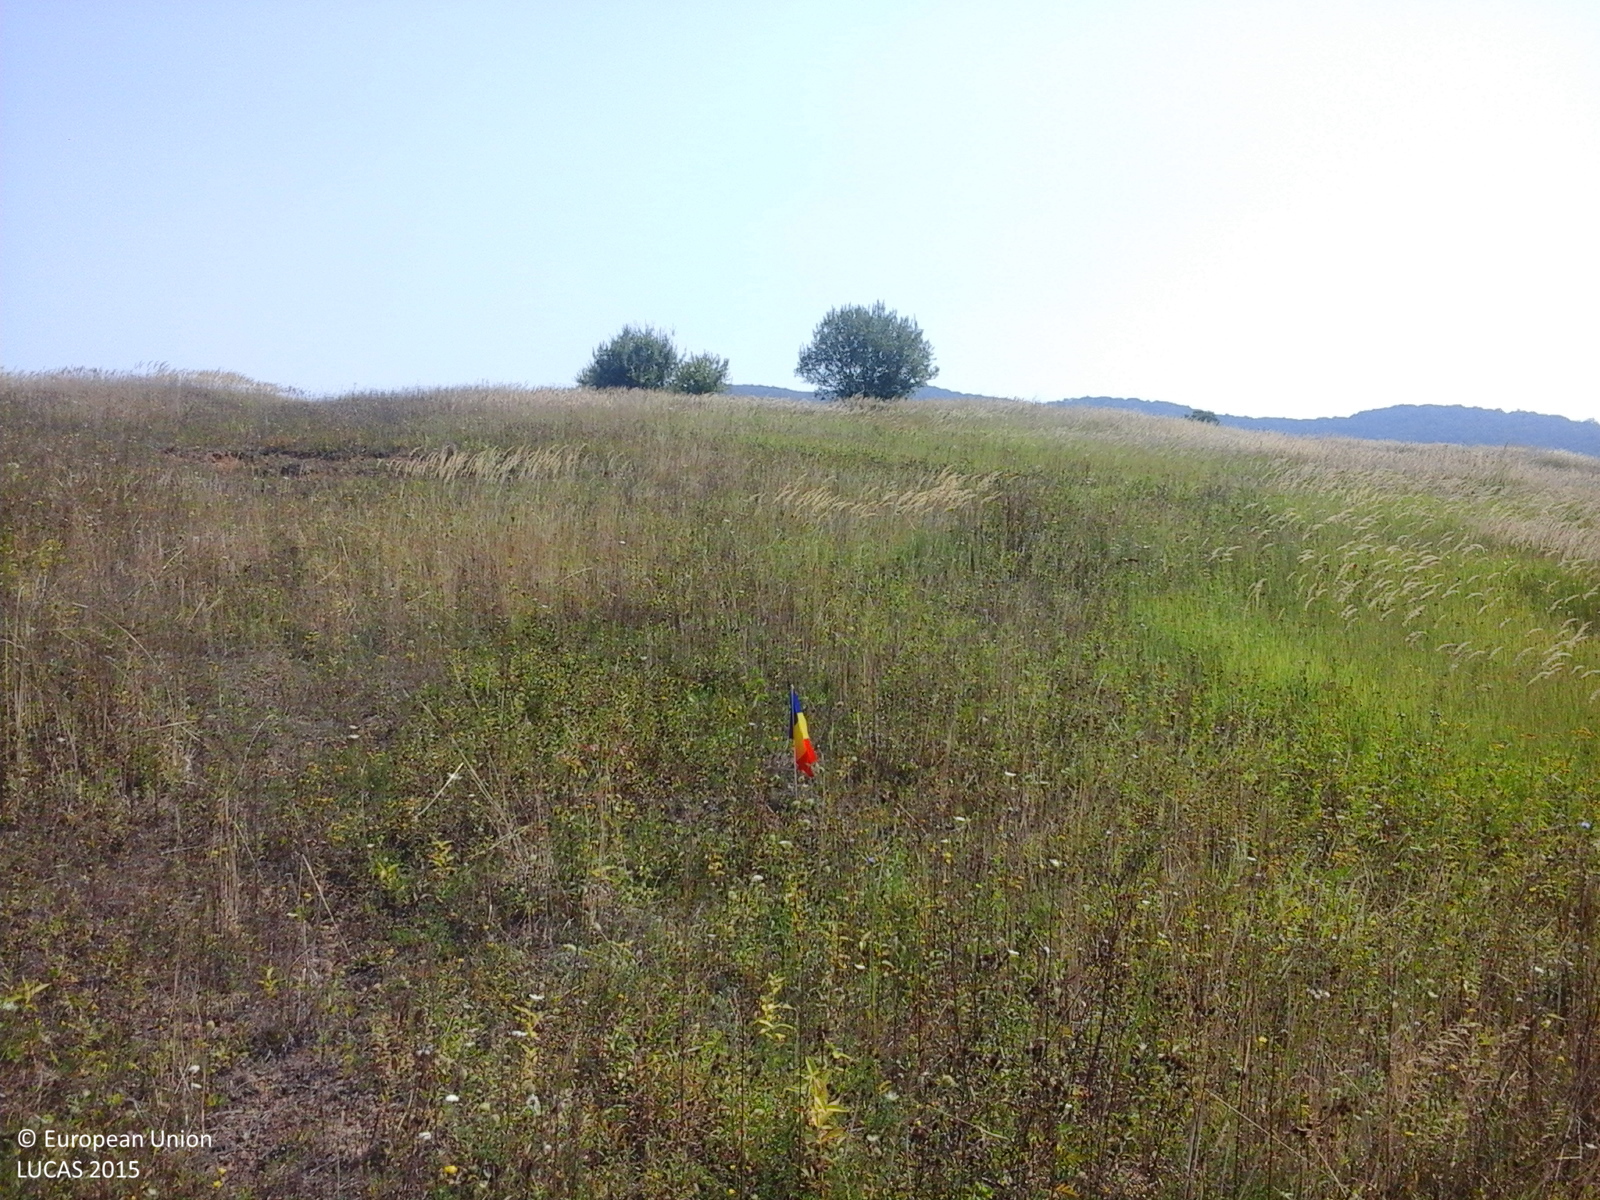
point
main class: Grassland
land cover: Grassland without tree/shrub cover
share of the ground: > 75 %
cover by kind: herbaceous plants 100 %
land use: Agriculture (excluding fallow land and kitchen gardens)
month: August
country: RO
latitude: 46.3069
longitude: 22.3443
